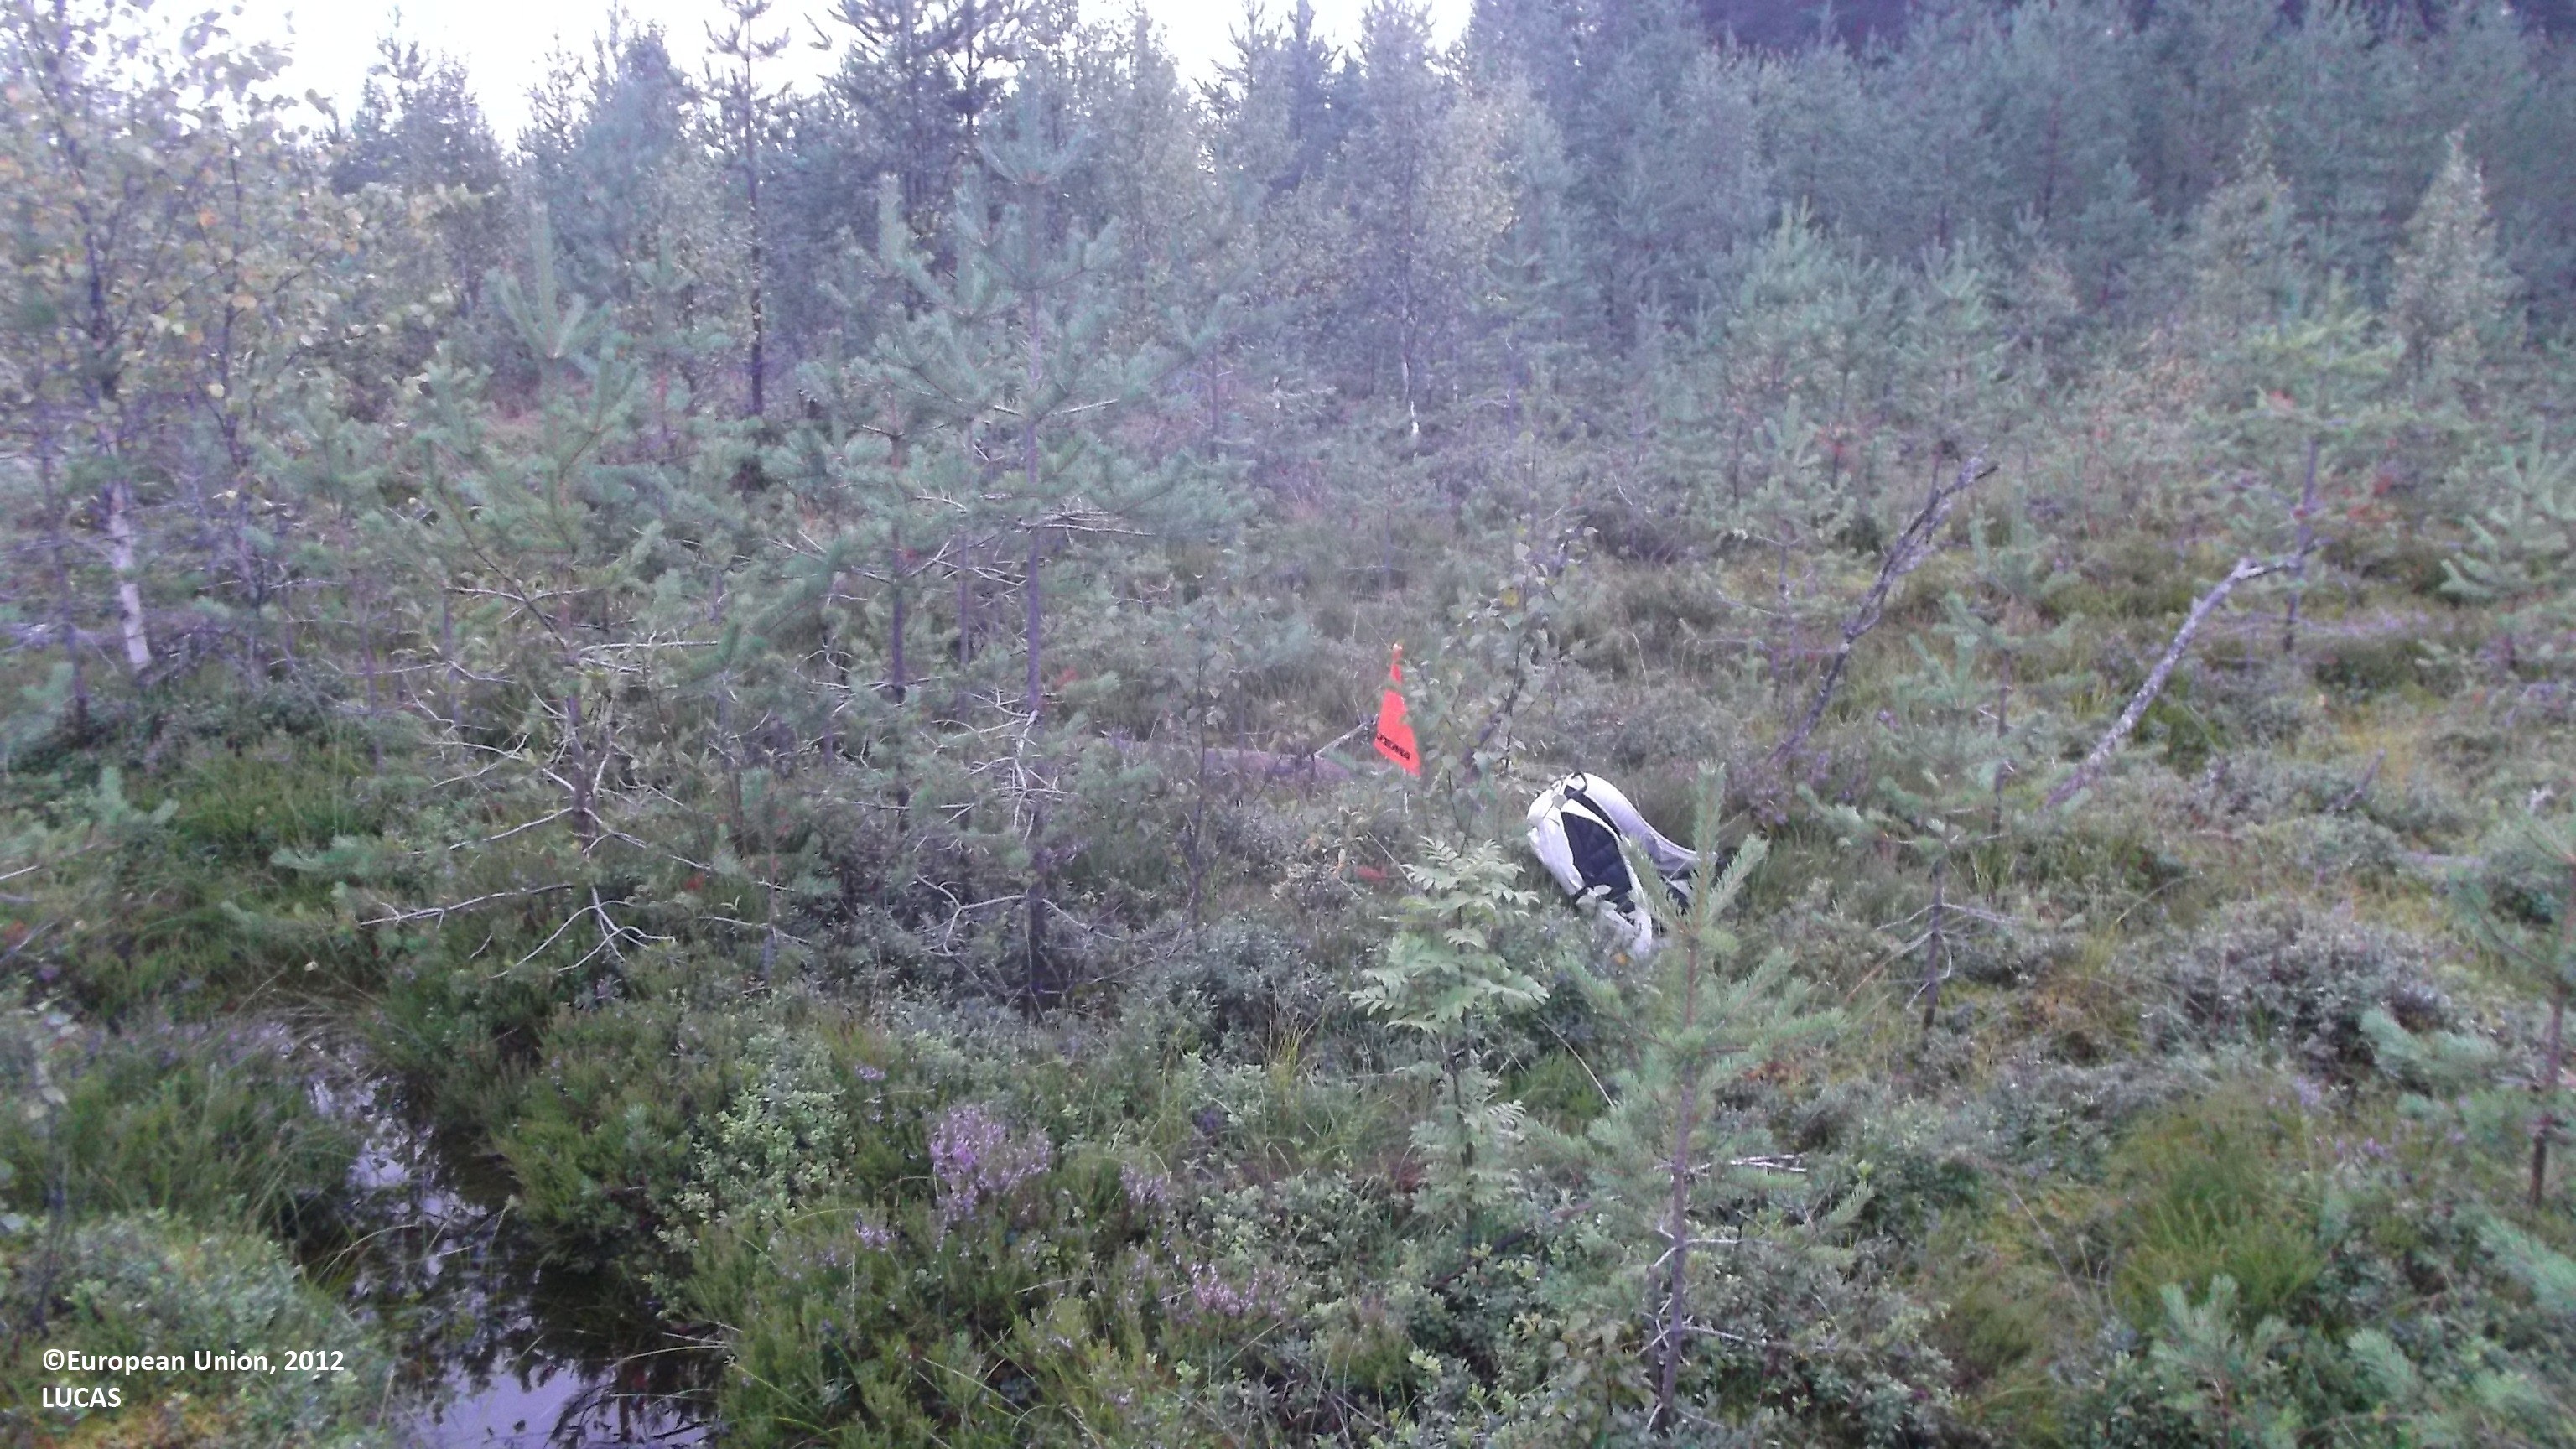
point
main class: Woodland
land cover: Other mixed woodland
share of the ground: < 10 %
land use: Forestry
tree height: < 5 m
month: August
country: FI
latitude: 63.1976
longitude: 24.4539
